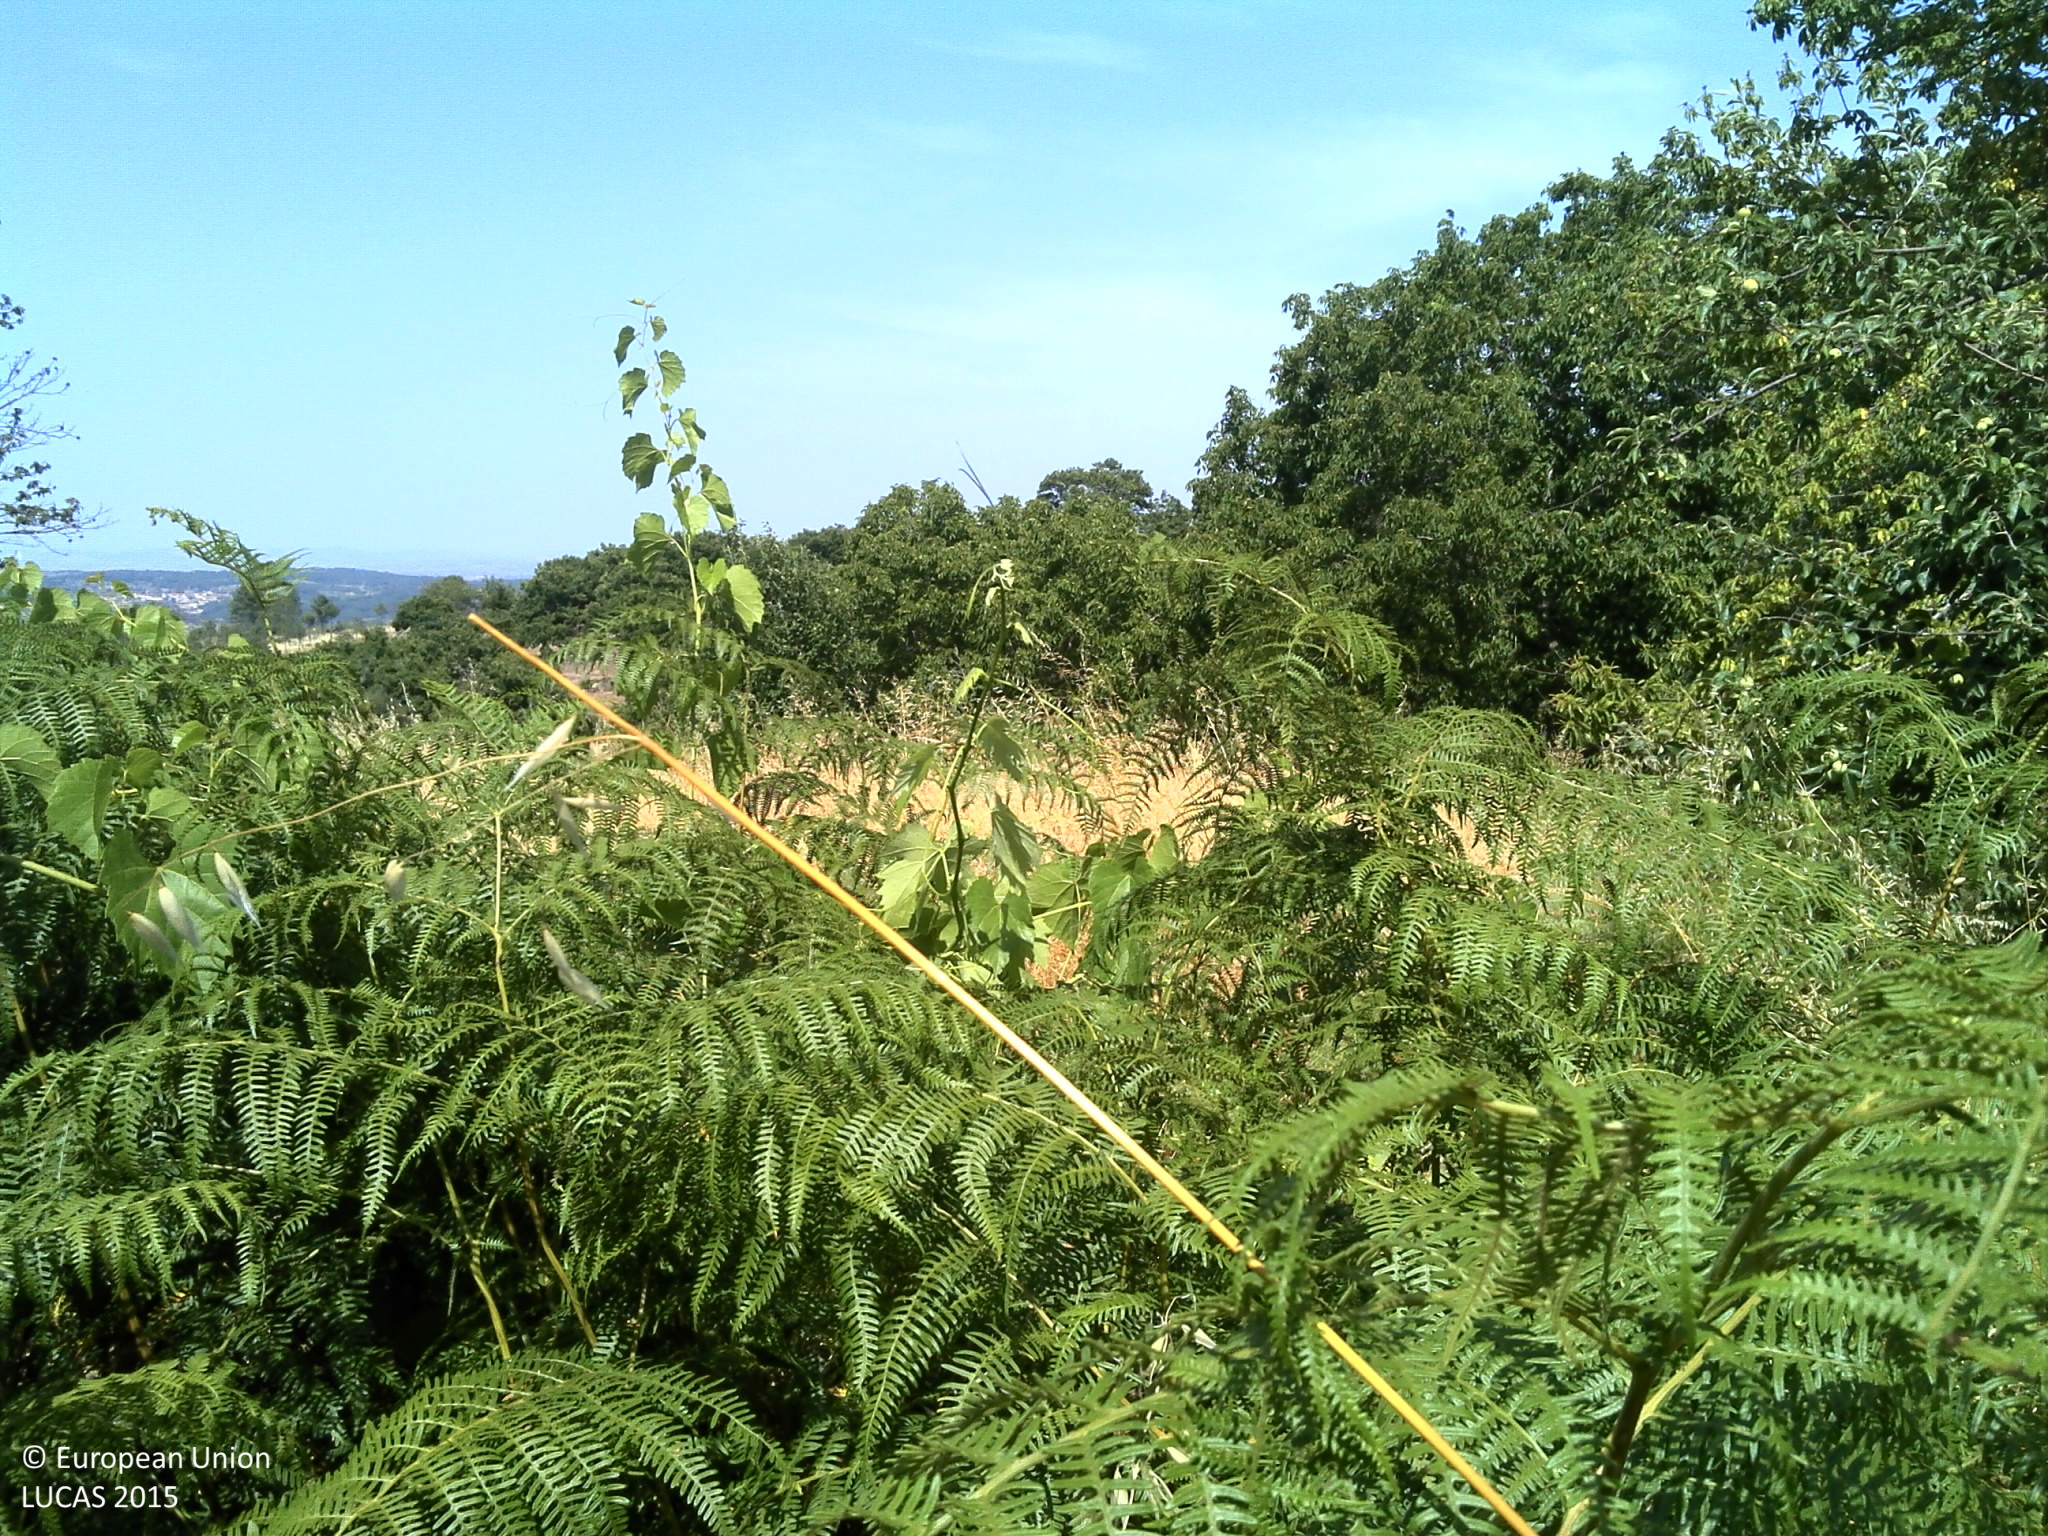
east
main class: Cropland
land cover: Vineyards
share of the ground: 10 - 25 %
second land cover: Spontaneously vegetated surfaces
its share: 25 - 50 %
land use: Abandoned areas
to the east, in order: Vineyards; Spontaneously vegetated surfaces; Dry stone walls; Grassland without tree/shrub cover; Dry stone walls; Grassland without tree/shrub cover; Dry stone walls; Rivers and streams; Shruby margins; Dry stone walls; Nuts trees; Dry stone walls; Other fruit trees and berries; Artificial constructions in urban areas; Dry stone walls; Grassland without tree/shrub cover; Dry stone walls; Shrubland without tree cover; Dry stone walls; Shrubland without tree cover; Dry stone walls; Spontaneously vegetated surfaces; Potatoes; Other fresh vegetables; Dry pulses; Dry stone walls; Nuts trees; Cherry fruit; Nuts trees; Shrubland with sparse tree cover; Dry stone walls; Shruby margins; Nuts trees
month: July
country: PT
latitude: 40.7959
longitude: -7.3327
